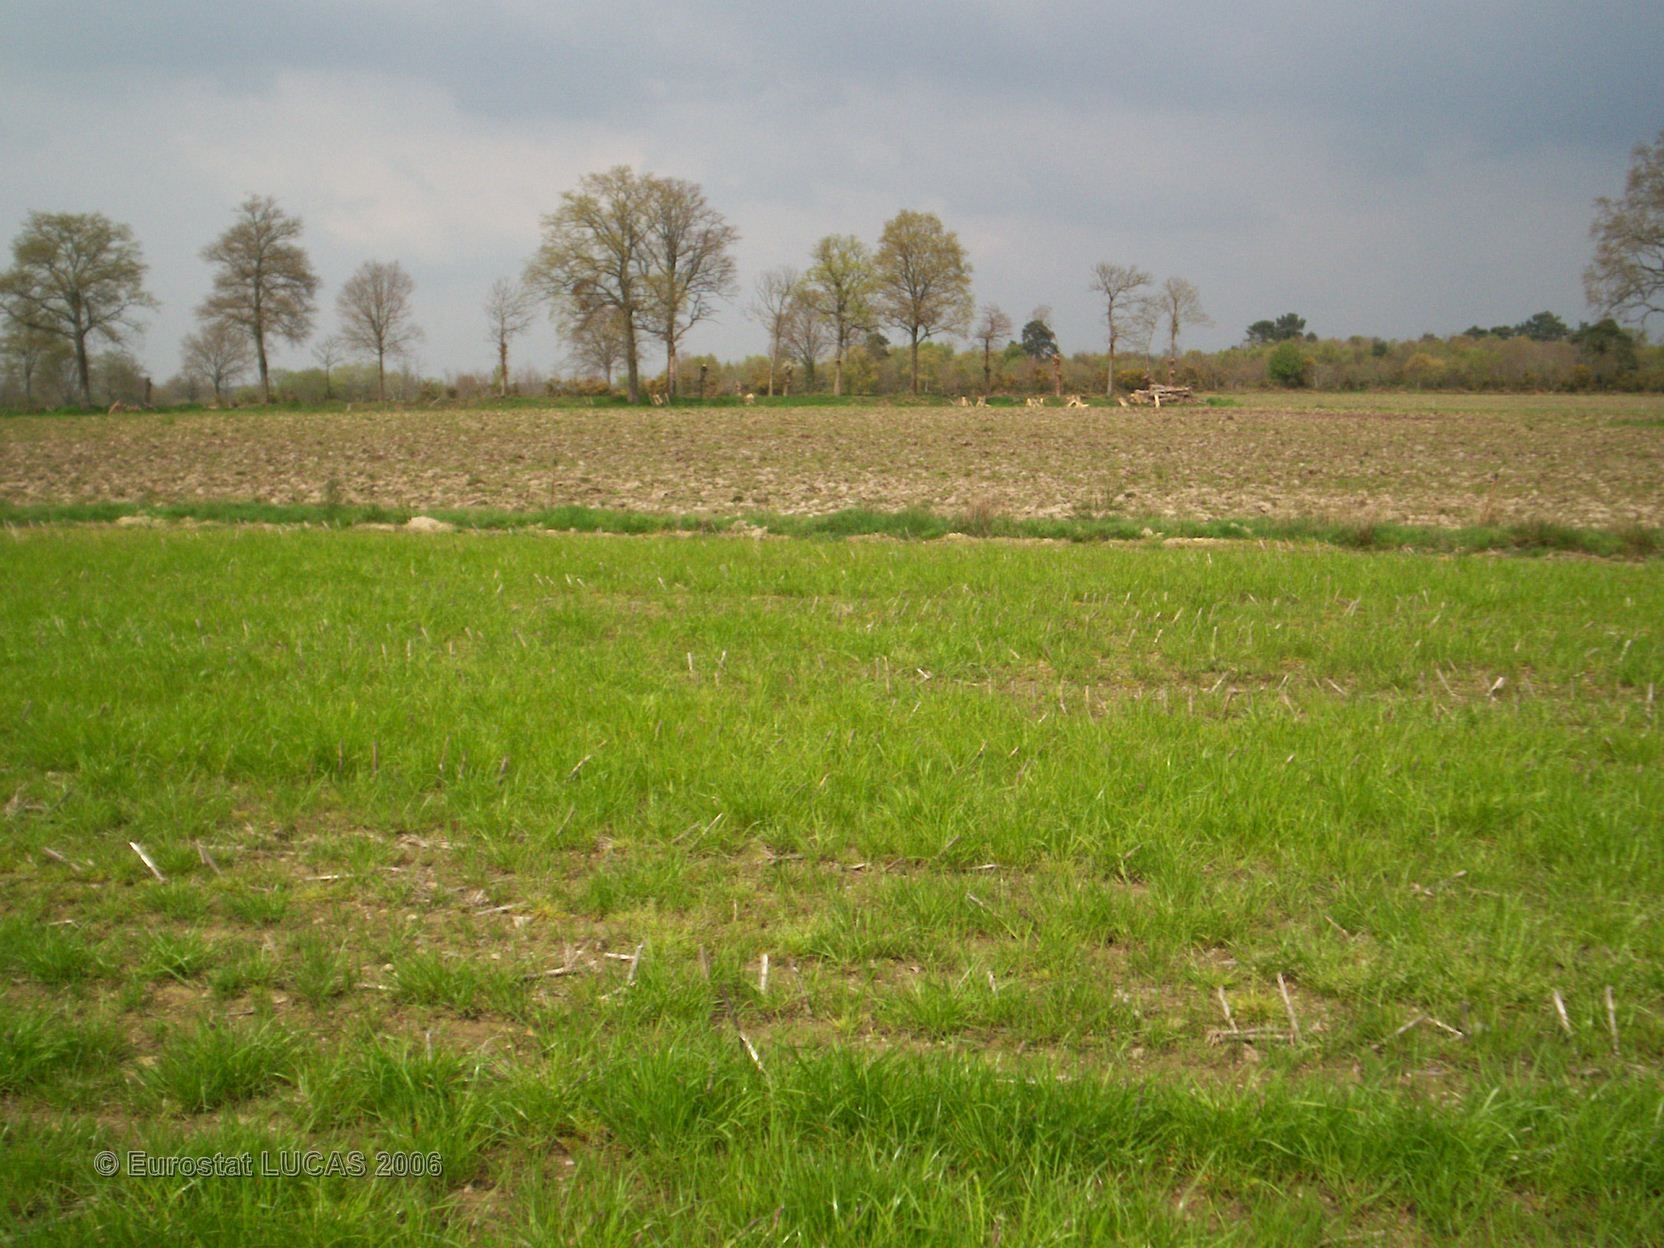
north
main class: Grassland
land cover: Grassland without tree/shrub cover
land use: Agriculture (excluding fallow land and kitchen gardens)
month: April
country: FR
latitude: 48.2331
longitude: -1.3669
